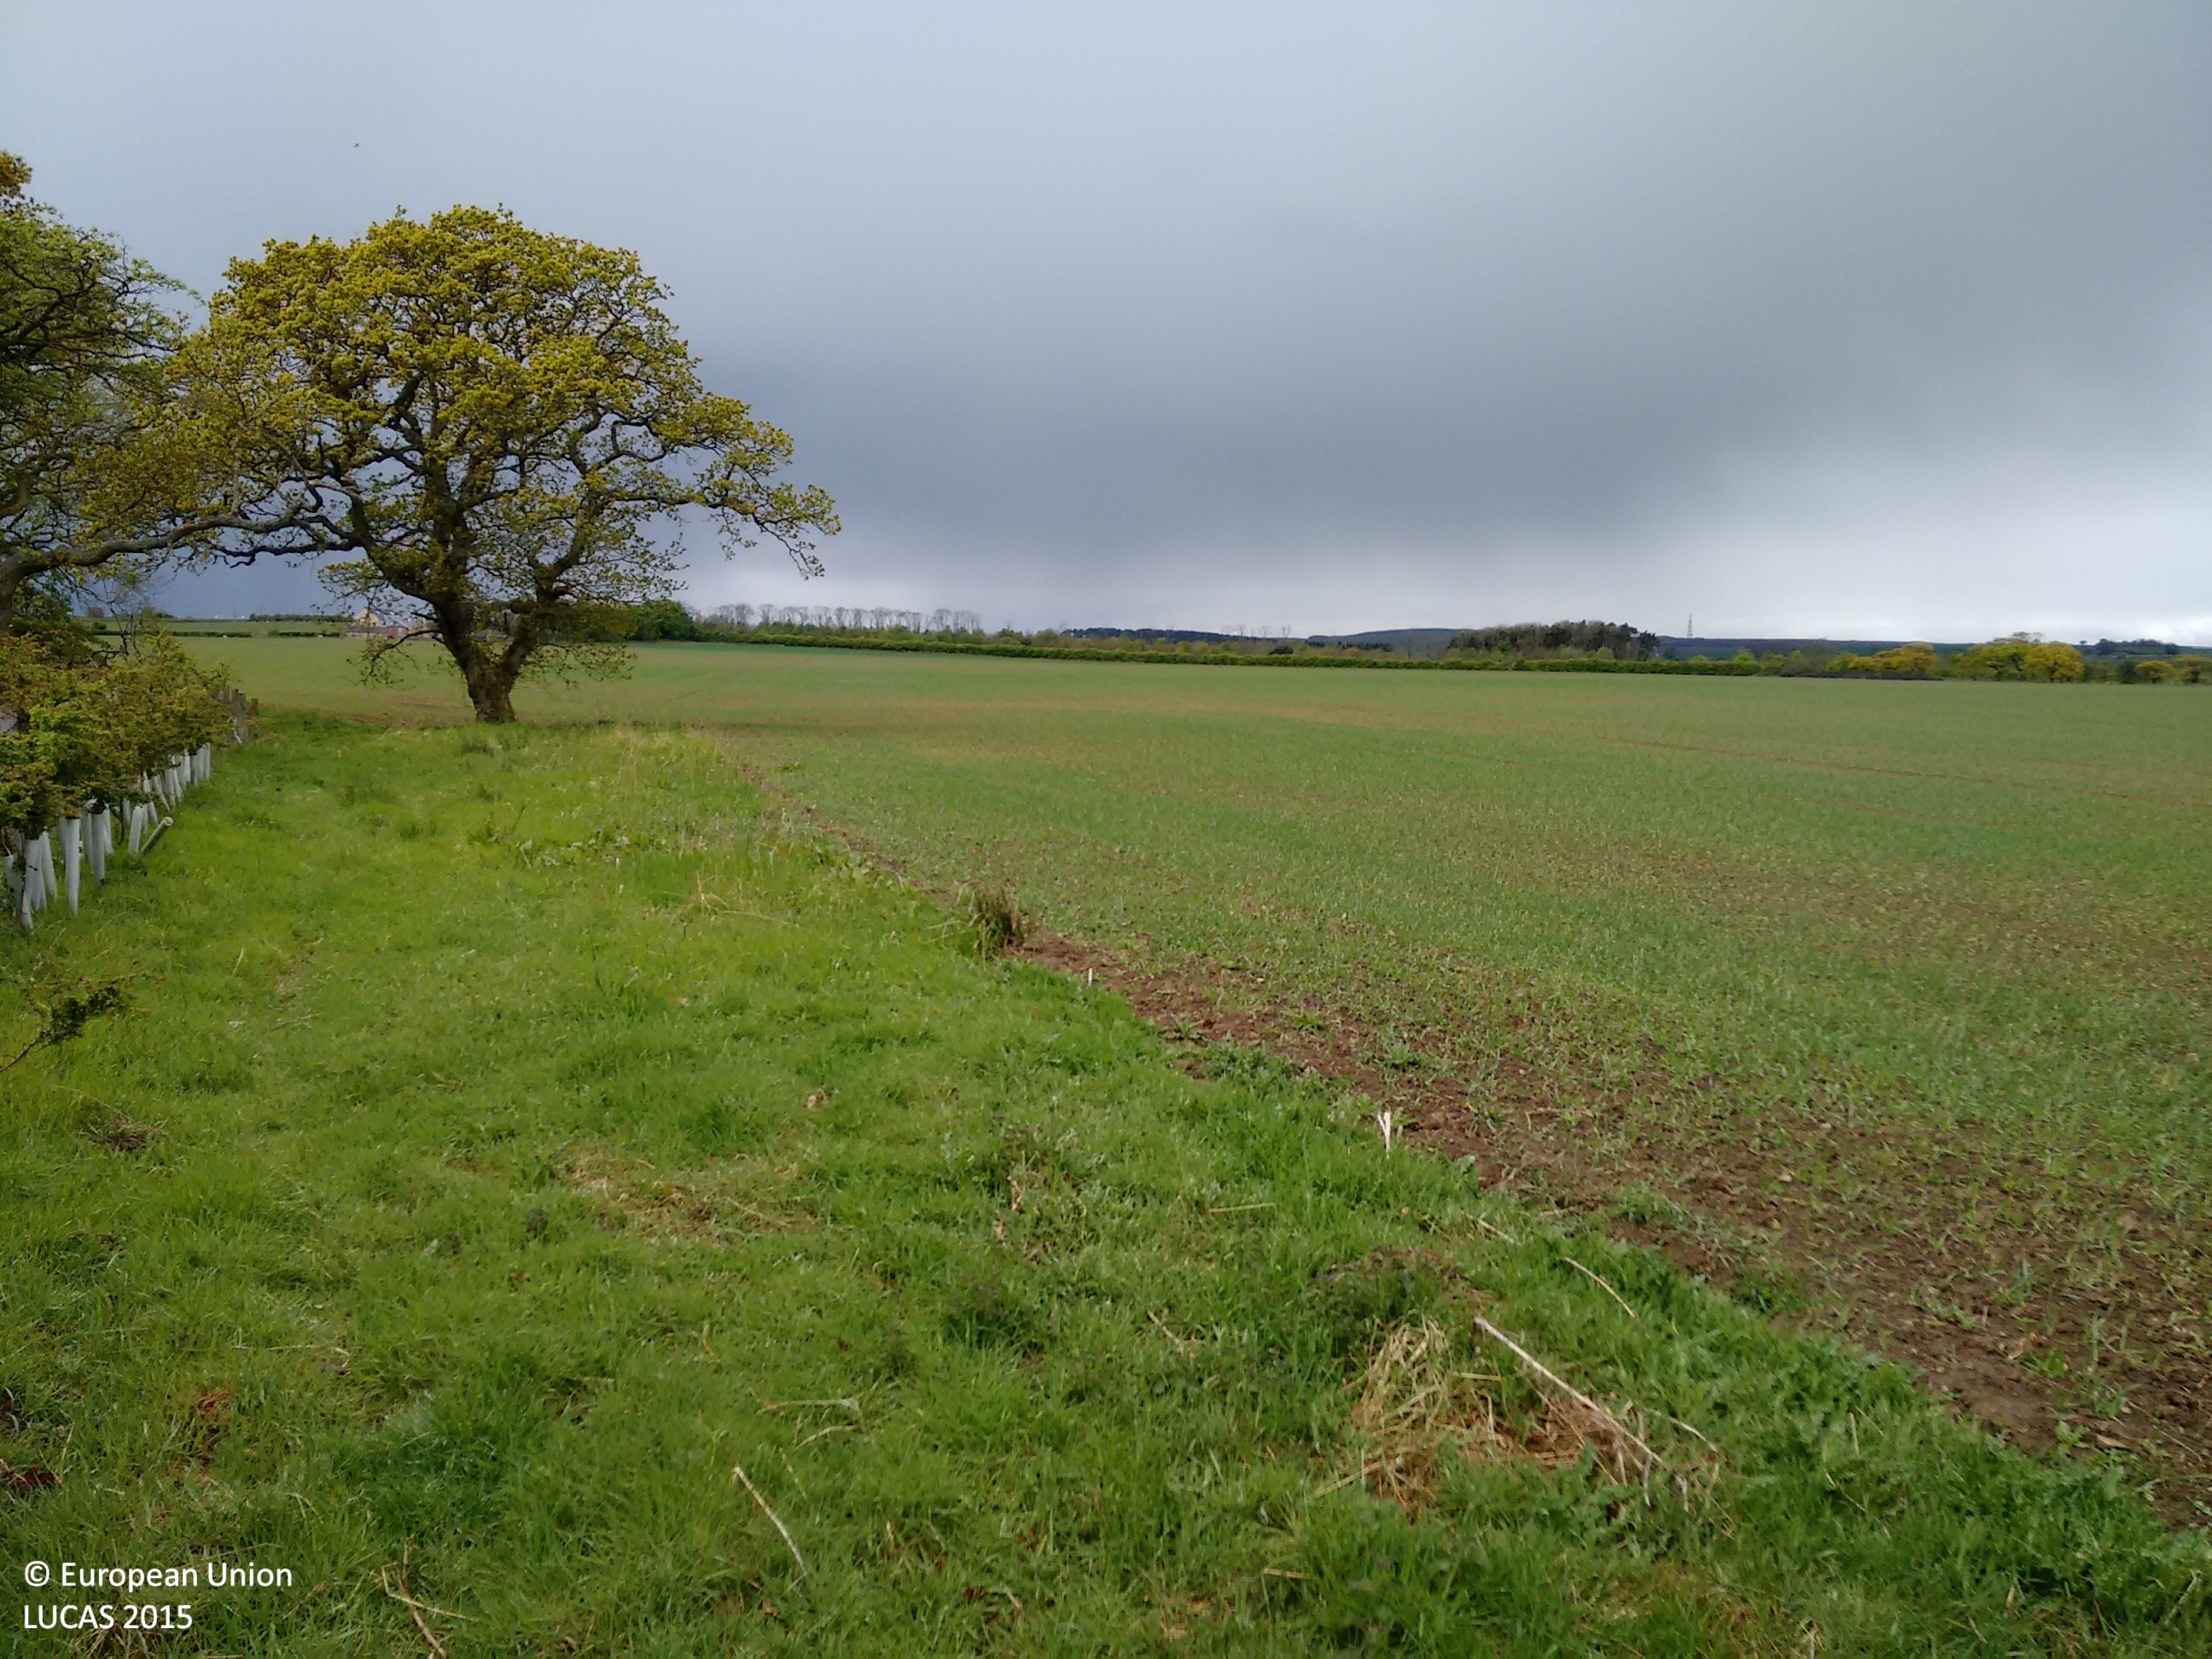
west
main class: Grassland
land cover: Grassland with sparse tree/shrub cover
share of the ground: > 75 %
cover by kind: herbaceous plants 95 %, broadleaved forest trees 5 %
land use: Agriculture (excluding fallow land and kitchen gardens)
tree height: > 5 m
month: May
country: GB
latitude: 55.3765
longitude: -1.7116
